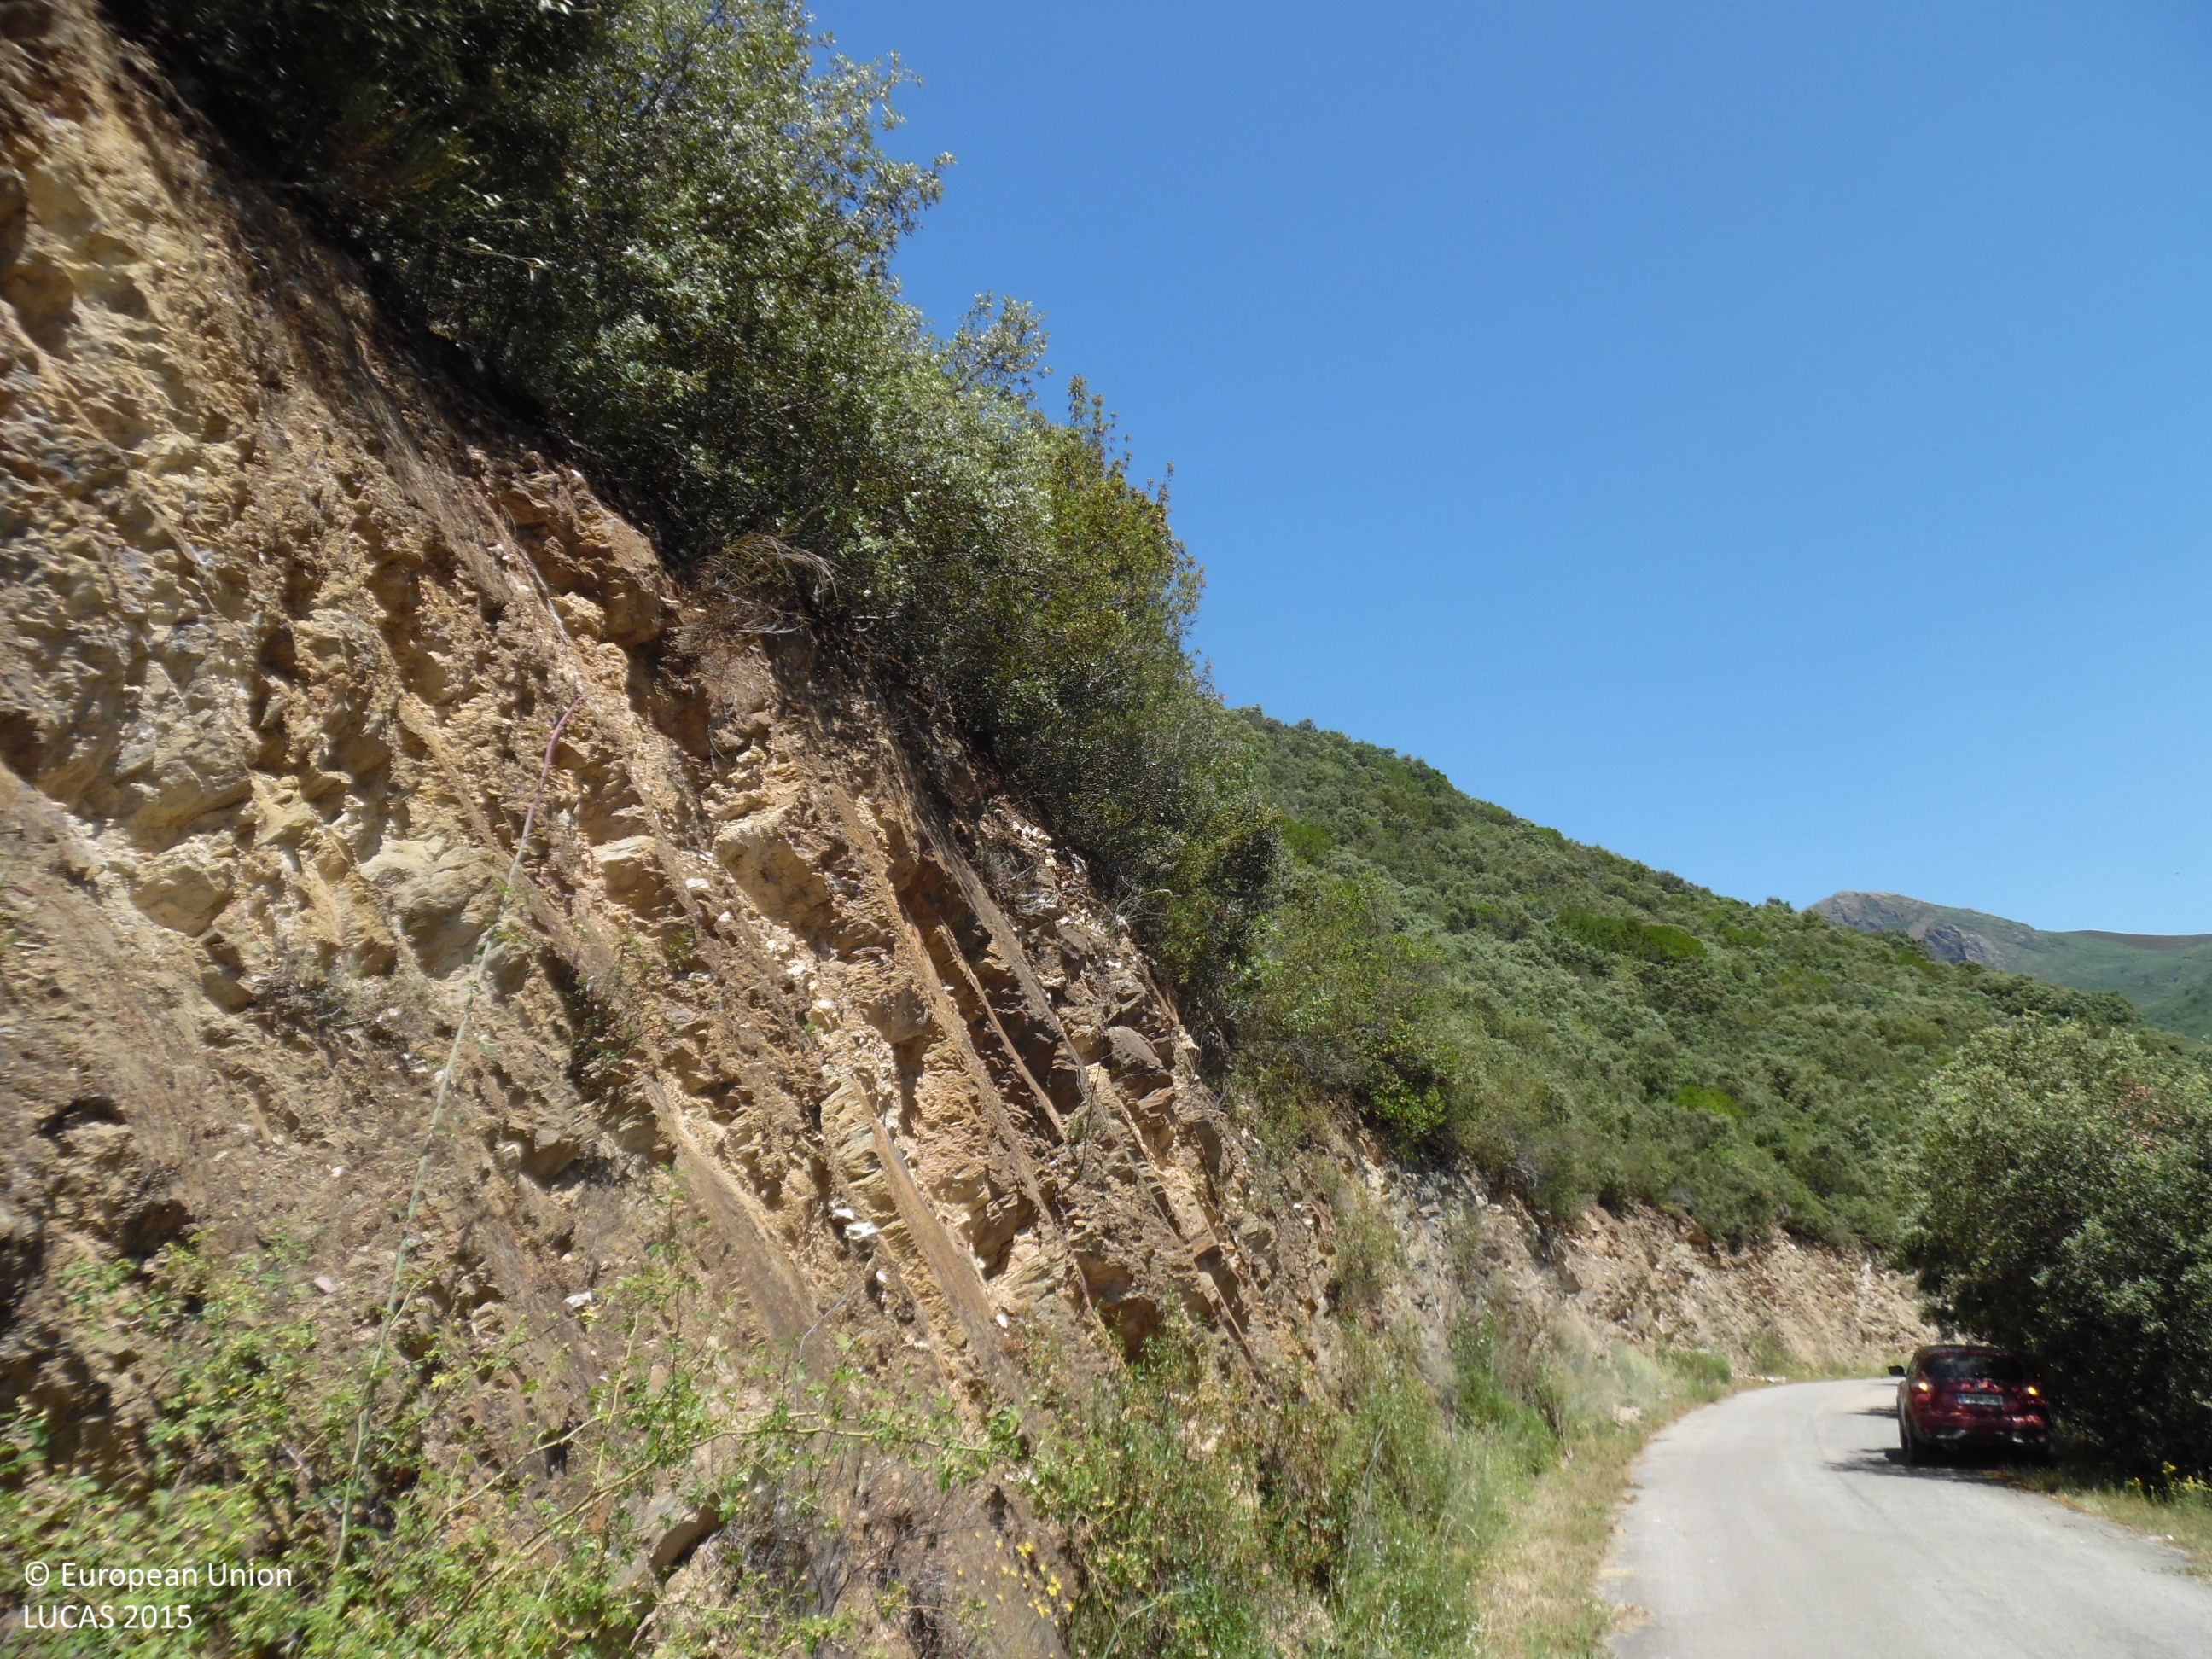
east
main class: Woodland
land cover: Broadleaved woodland
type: broadleaved evergreen forest
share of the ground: > 75 %
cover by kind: broadleaved forest trees 95 %, shrubs 5 %
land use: Forestry
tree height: > 5 m
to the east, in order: Broadleaved woodland
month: June
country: ES
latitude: 42.4667
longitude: -6.7228
